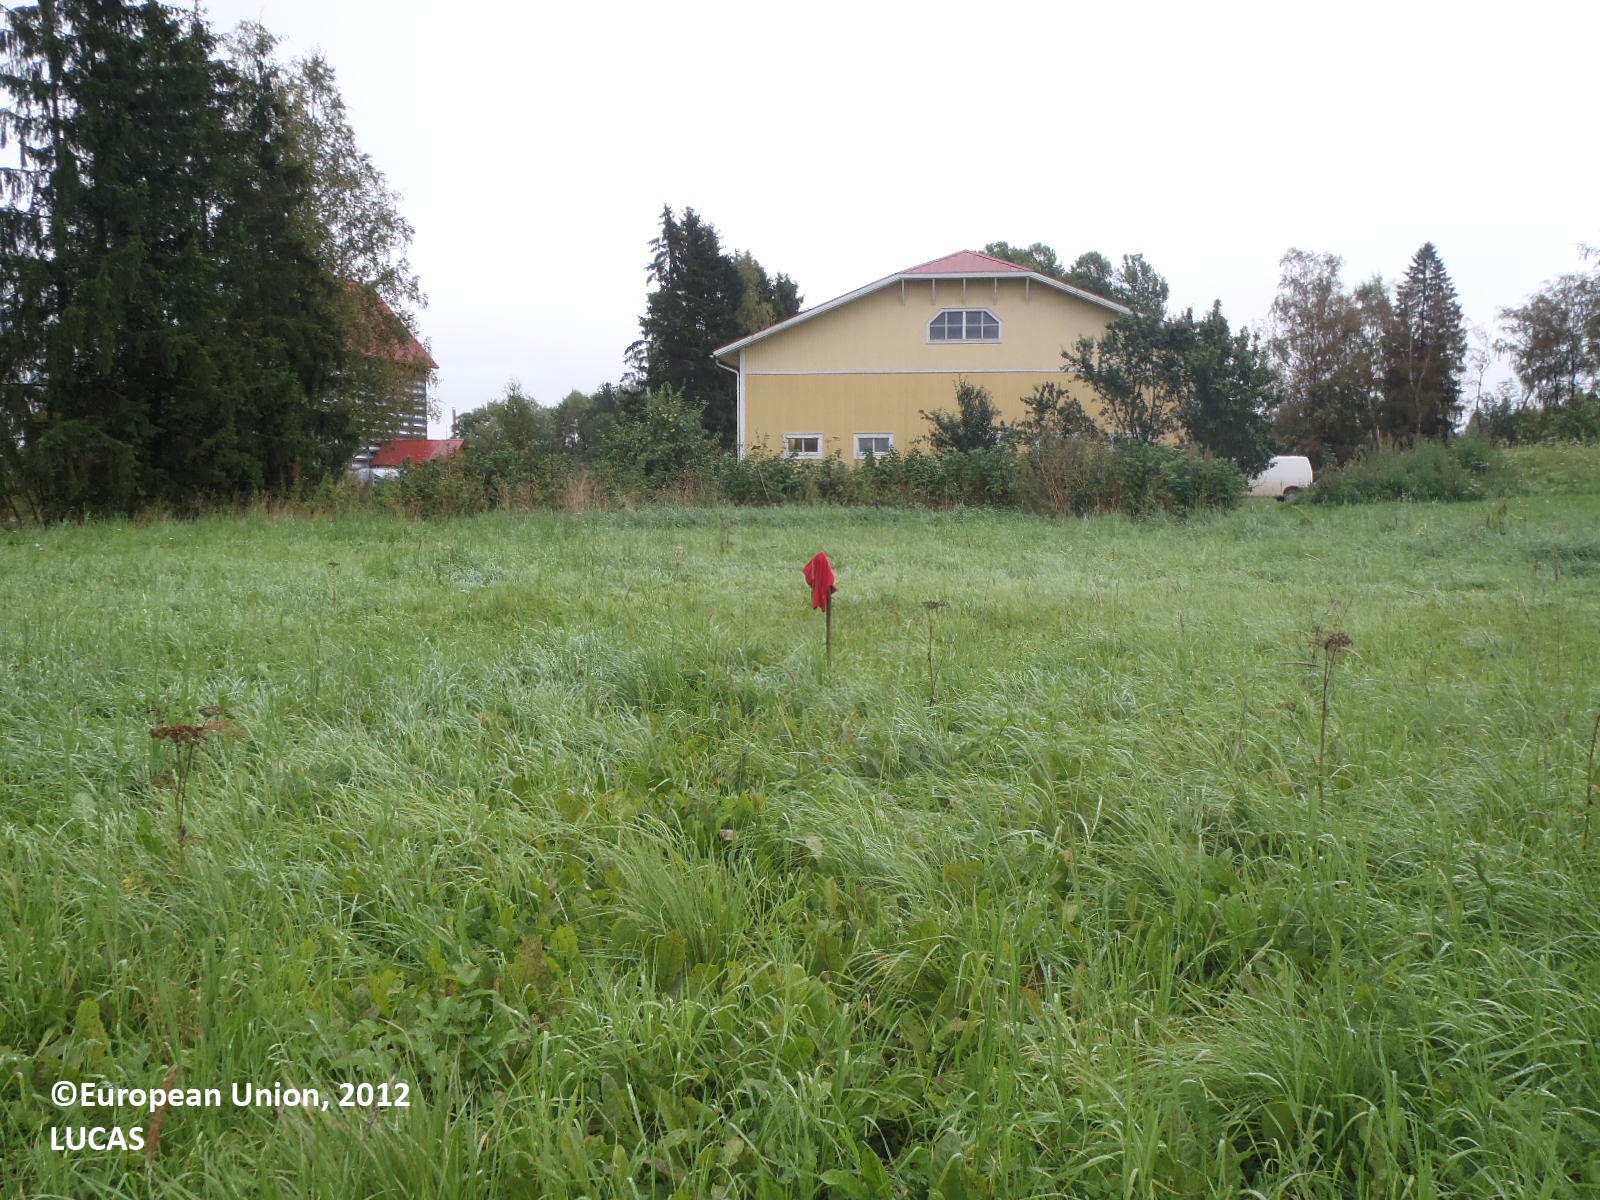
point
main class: Grassland
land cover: Grassland without tree/shrub cover
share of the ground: > 75 %
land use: Agriculture (excluding fallow land and kitchen gardens)
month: September
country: FI
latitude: 61.0315
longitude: 22.6741
